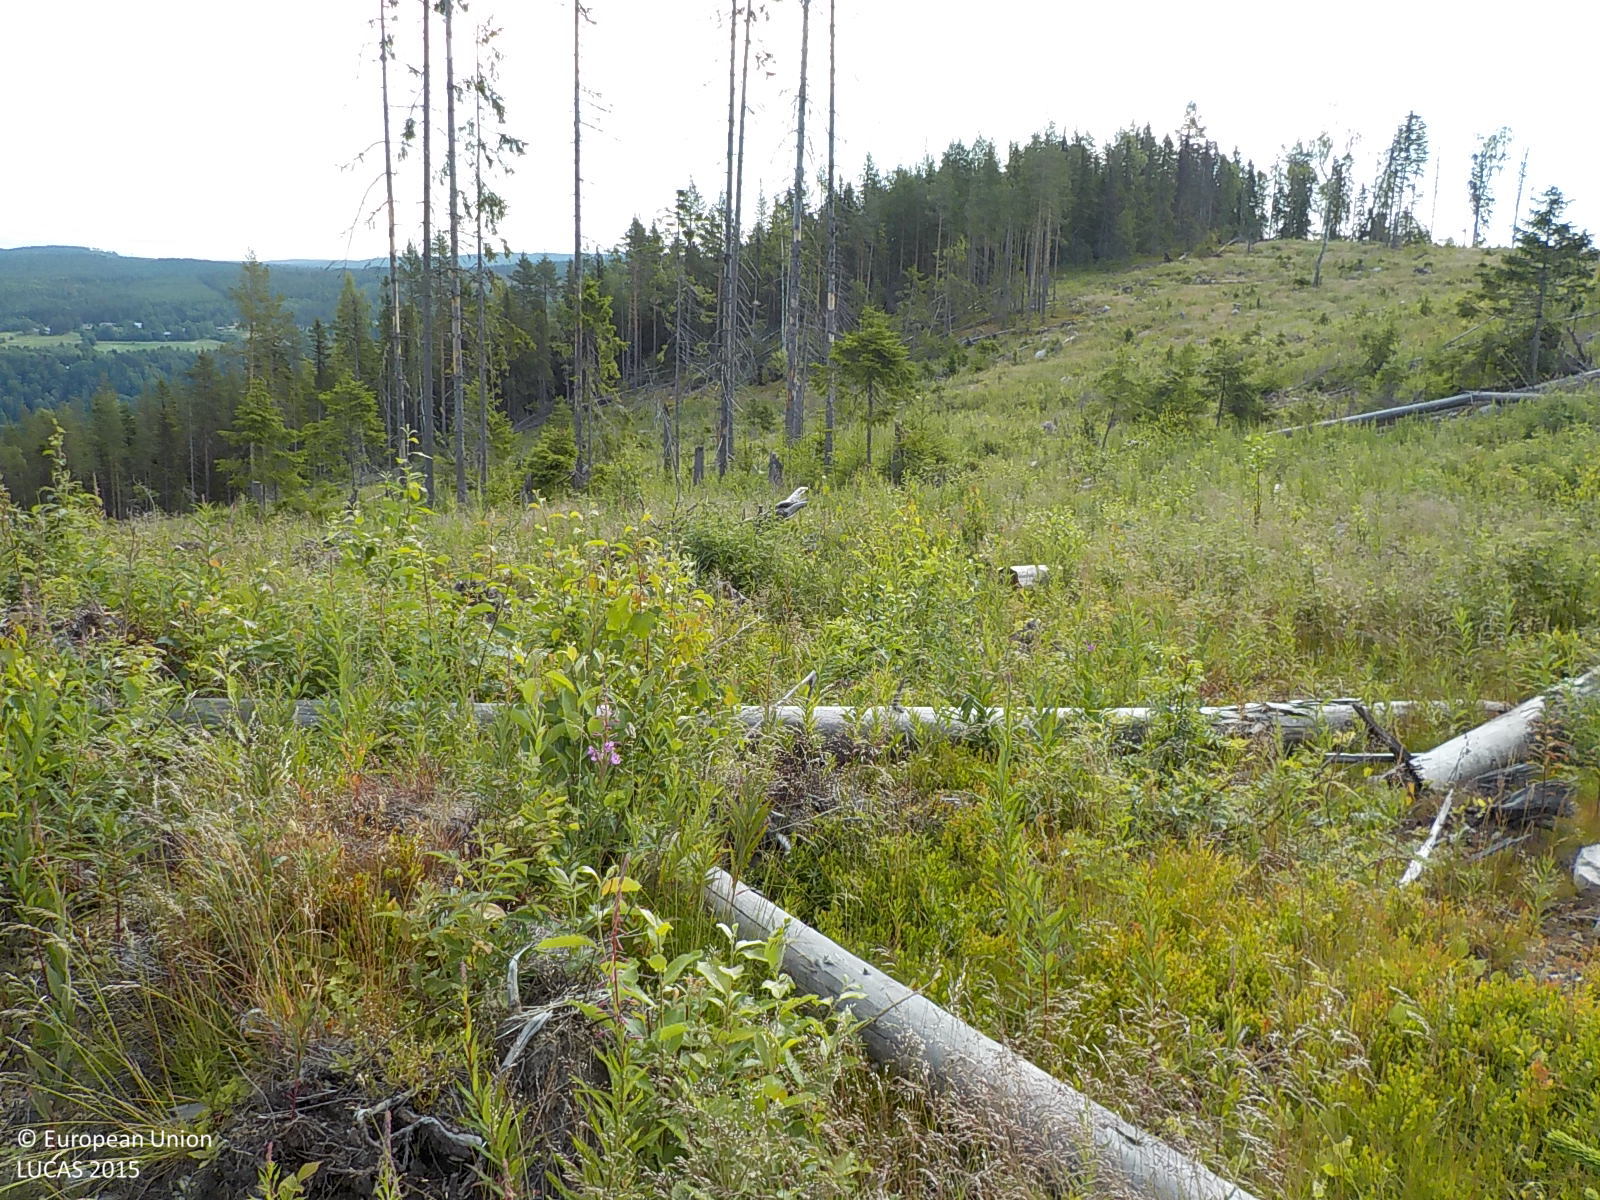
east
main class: Woodland
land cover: Other mixed woodland
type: boreal forest
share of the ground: 25 - 50 %
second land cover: Grassland without tree/shrub cover
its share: 25 - 50 %
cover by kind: herbaceous plants 35 %, coniferous forest trees 30 %, broadleaved forest trees 30 %, shrubs 5 %
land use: Forestry
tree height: < 5 m
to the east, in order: Other mixed woodland; Grassland without tree/shrub cover; Spruce dominated coniferous woodland
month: July
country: SE
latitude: 63.2015
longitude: 17.1923
